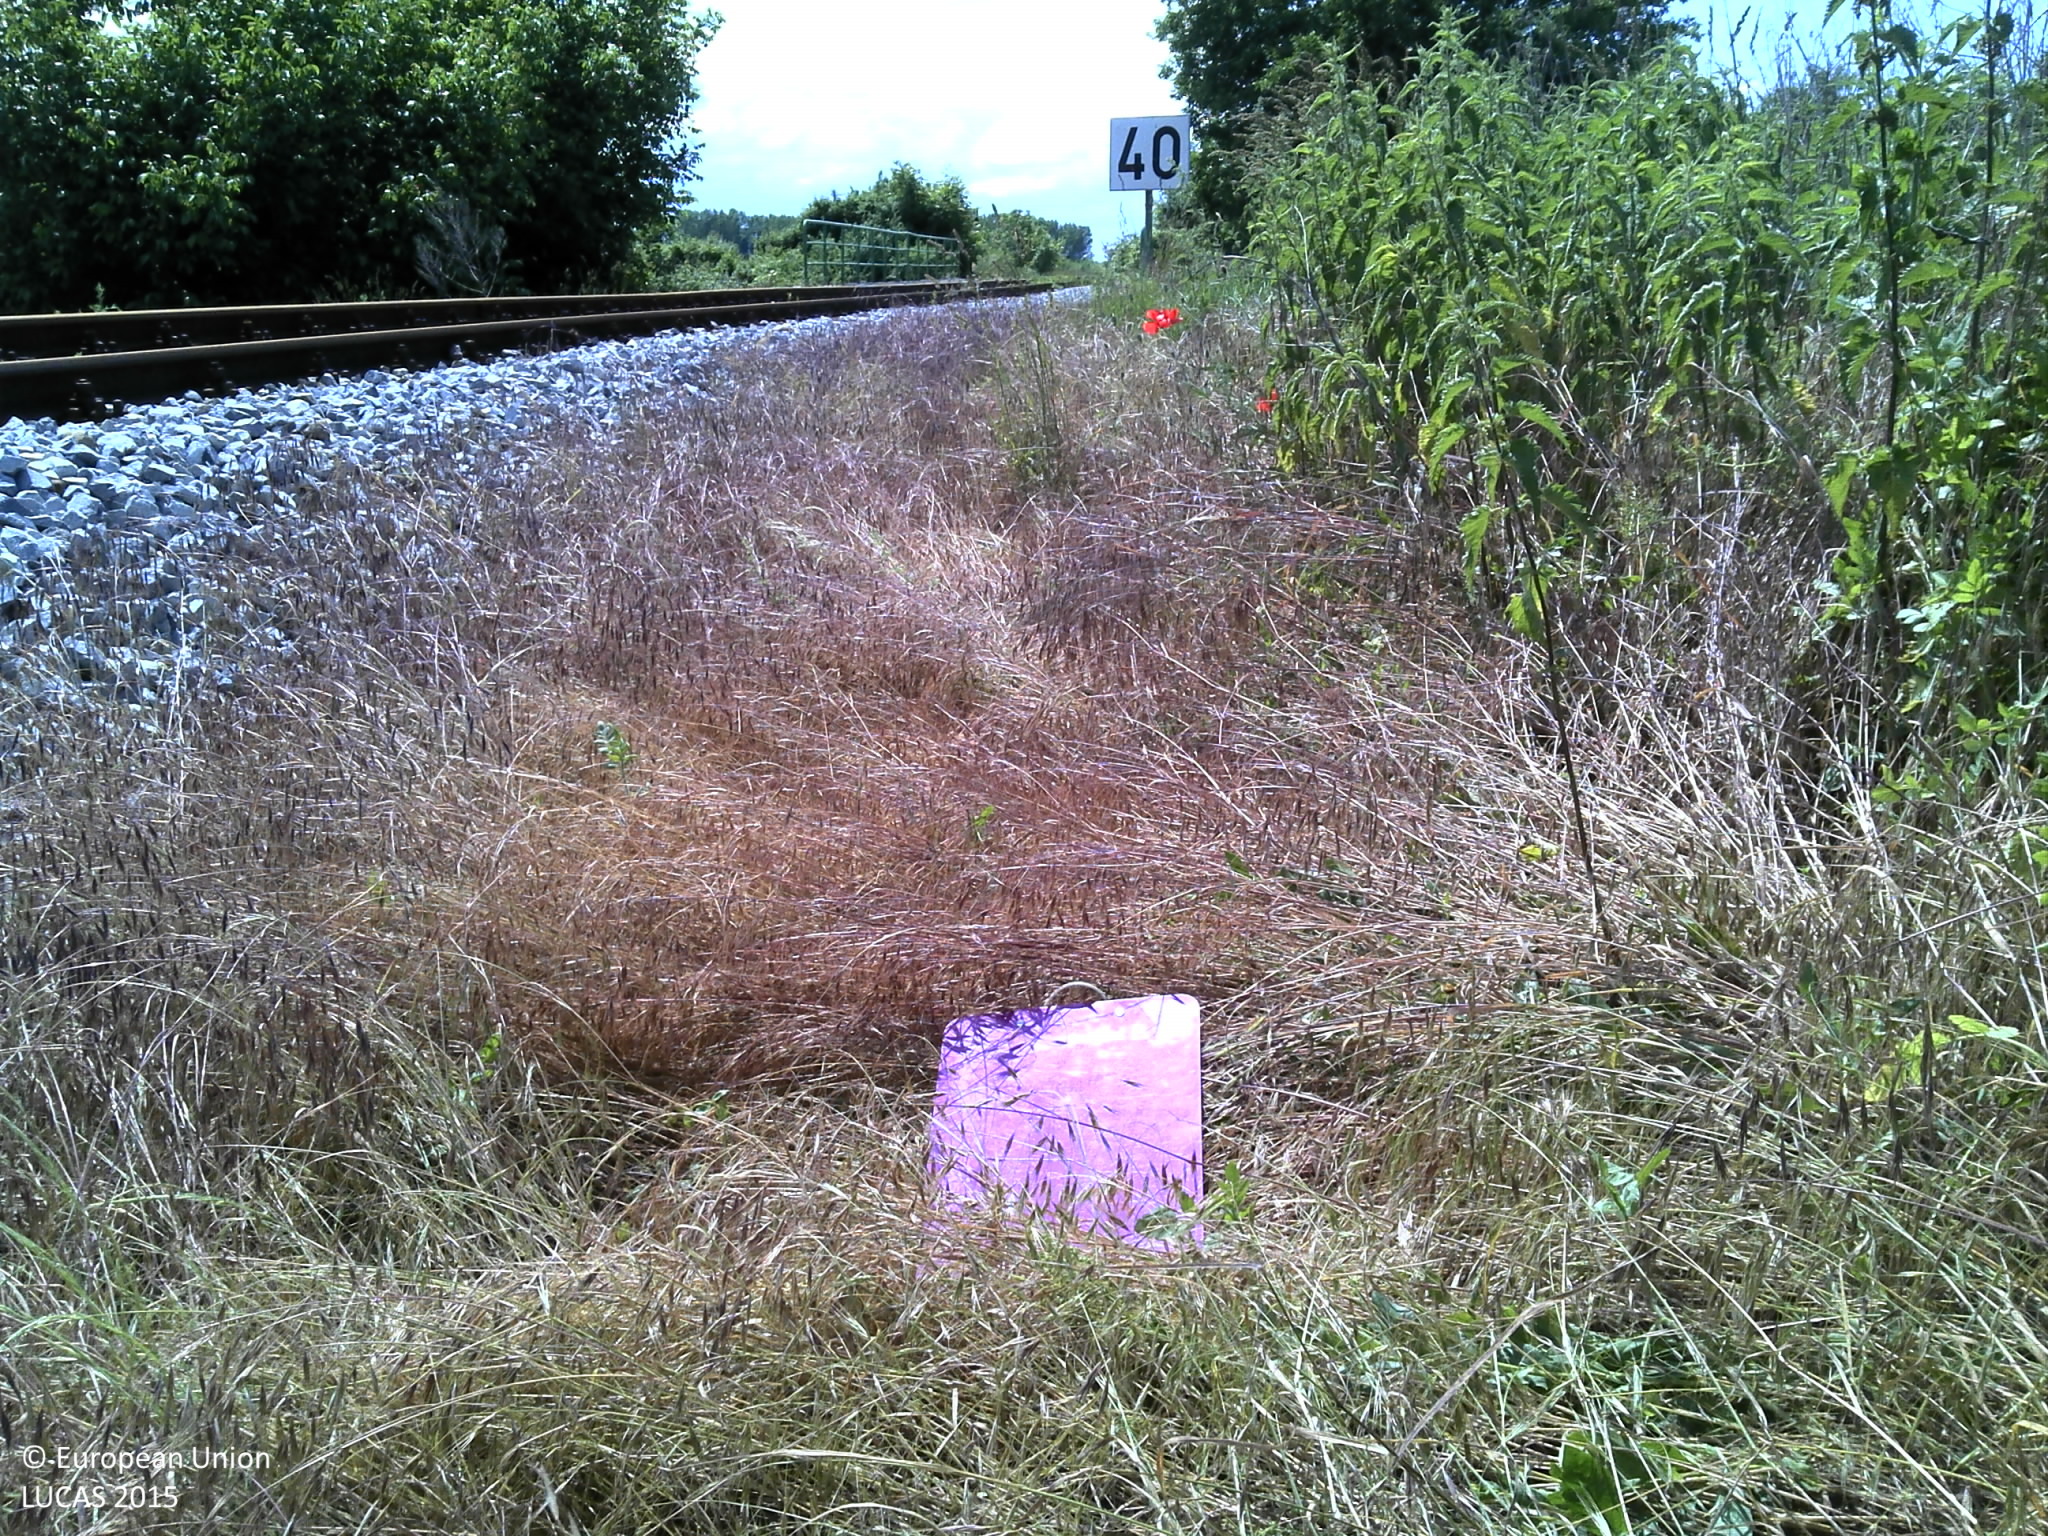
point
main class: Grassland
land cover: Grassland with sparse tree/shrub cover
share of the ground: > 75 %
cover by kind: herbaceous plants 85 %, shrubs 10 %, broadleaved forest trees 5 %
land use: Railway transport
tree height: < 5 m
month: May
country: HR
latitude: 45.5016
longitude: 18.9807
